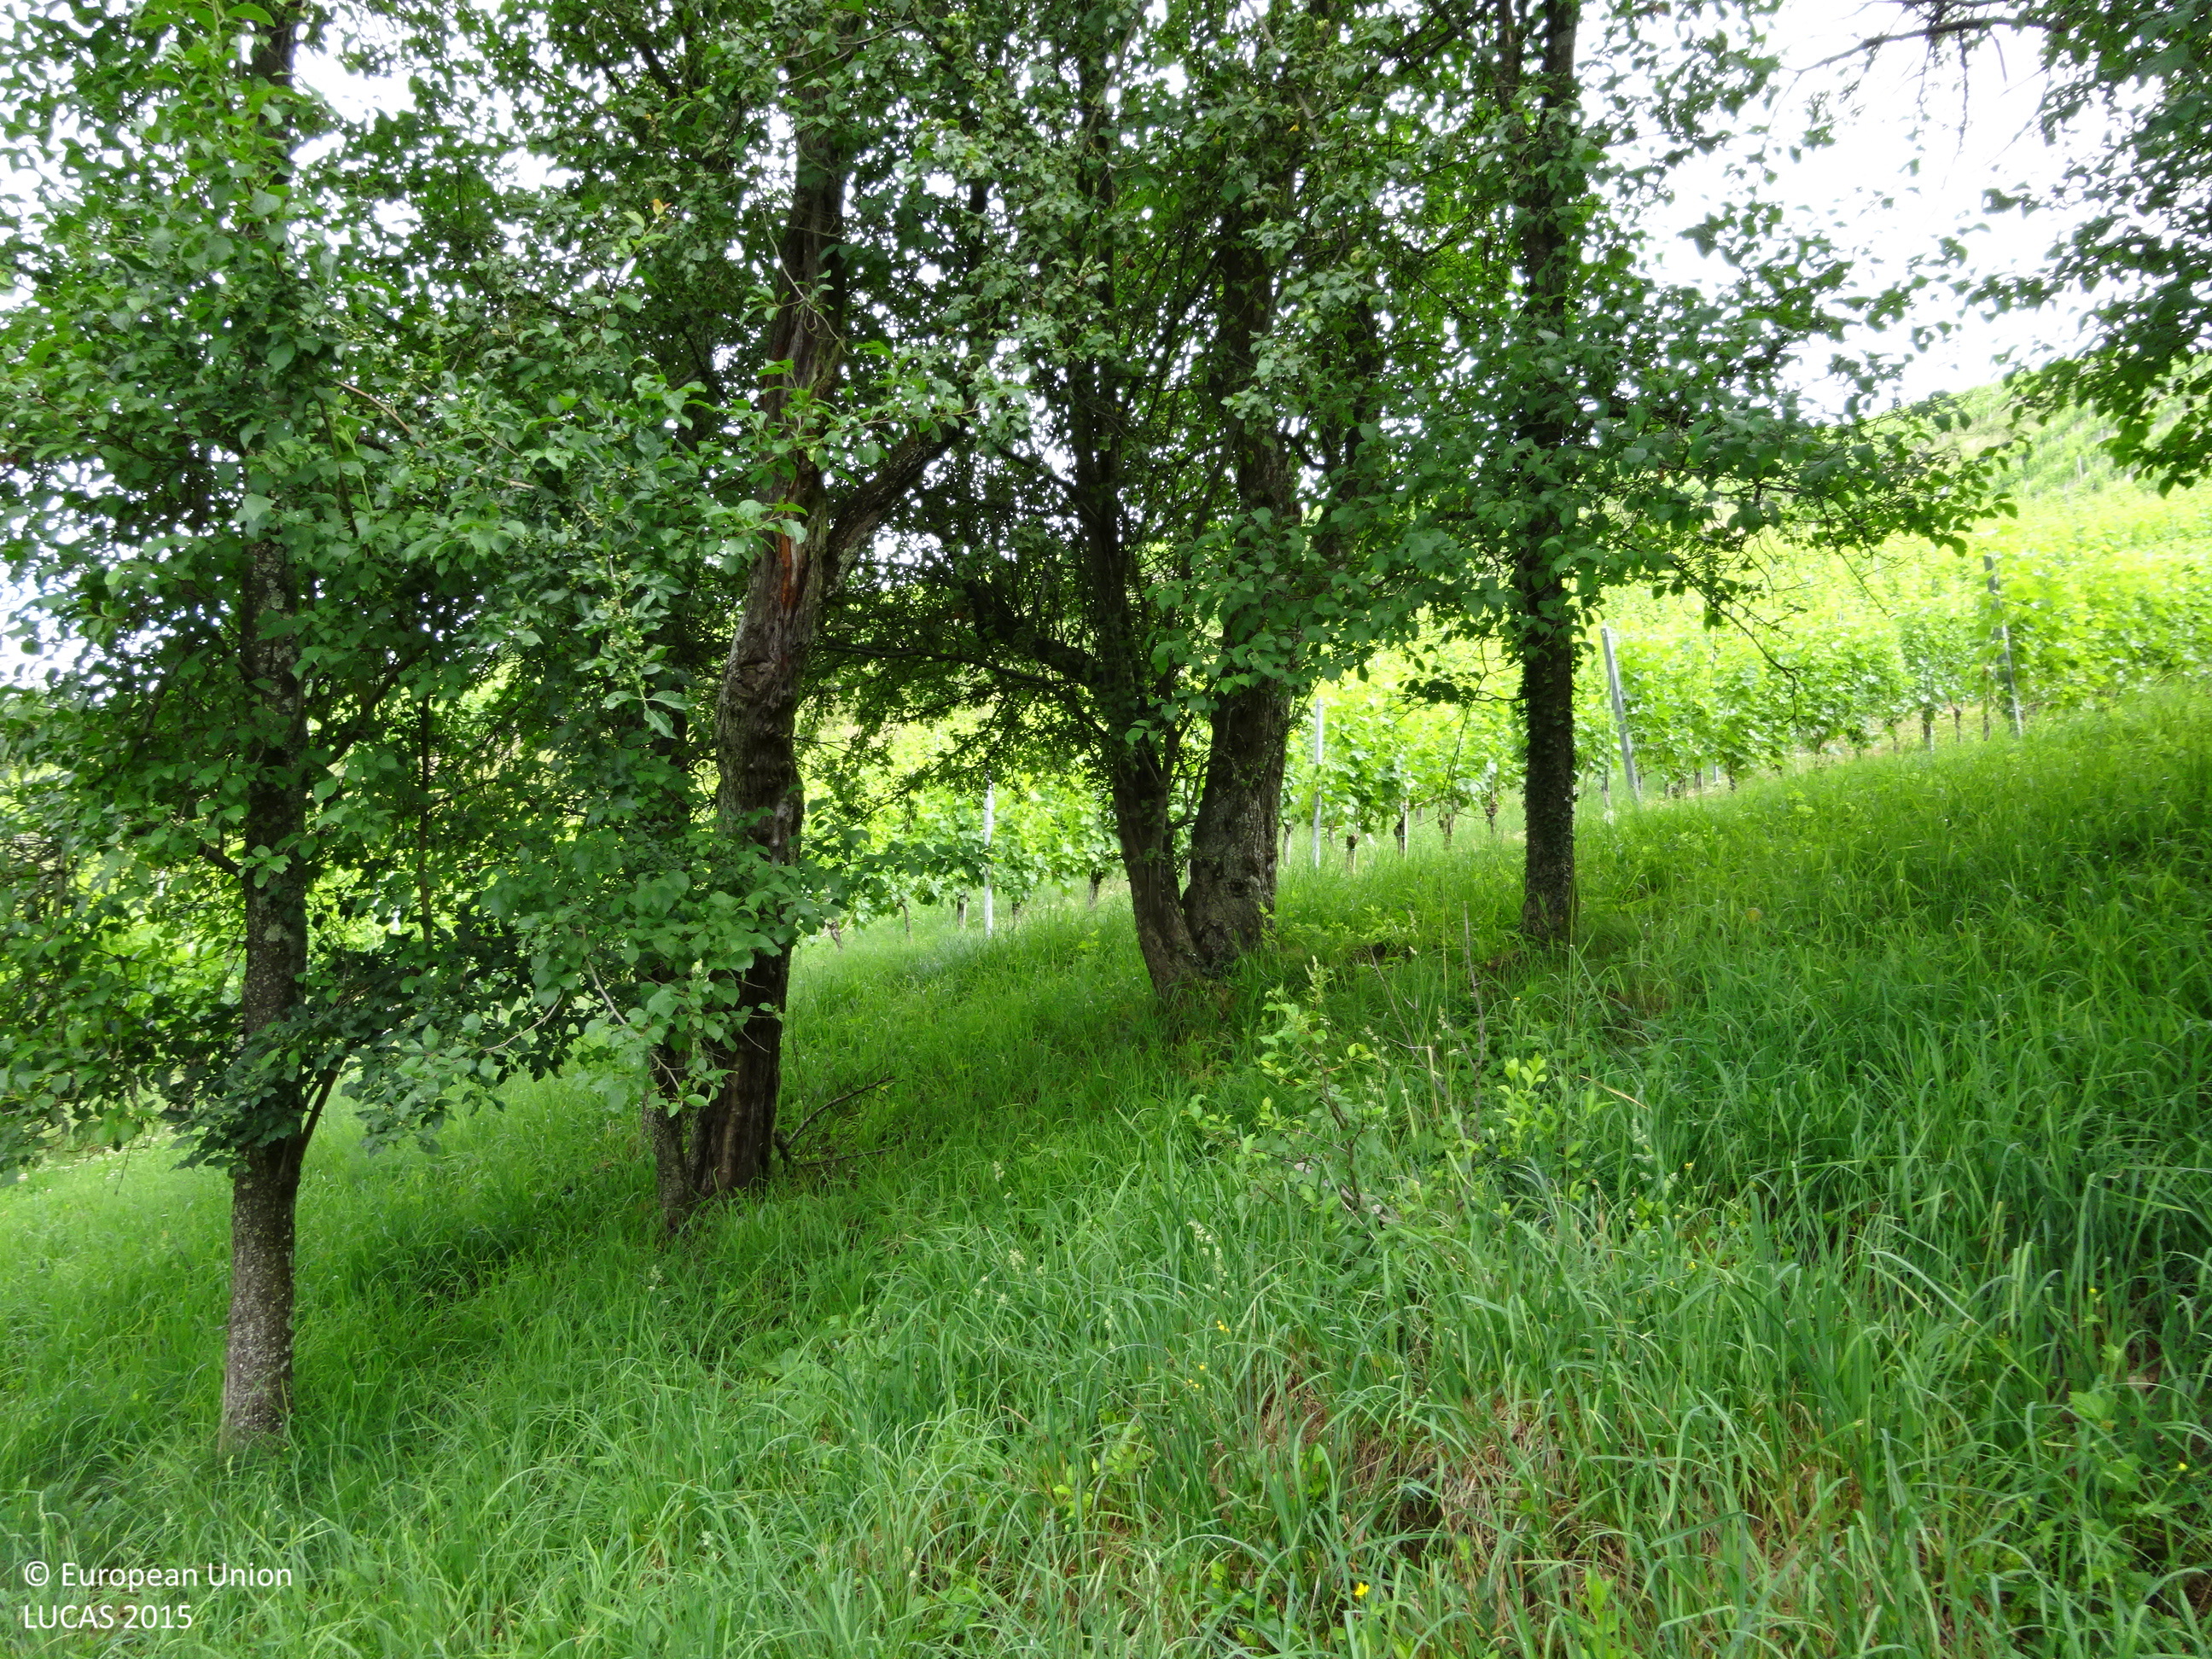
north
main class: Cropland
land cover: Apple fruit
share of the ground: 25 - 50 %
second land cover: Grassland without tree/shrub cover
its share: > 75 %
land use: Kitchen garden
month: June
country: AT
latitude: 46.7726
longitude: 15.4339
